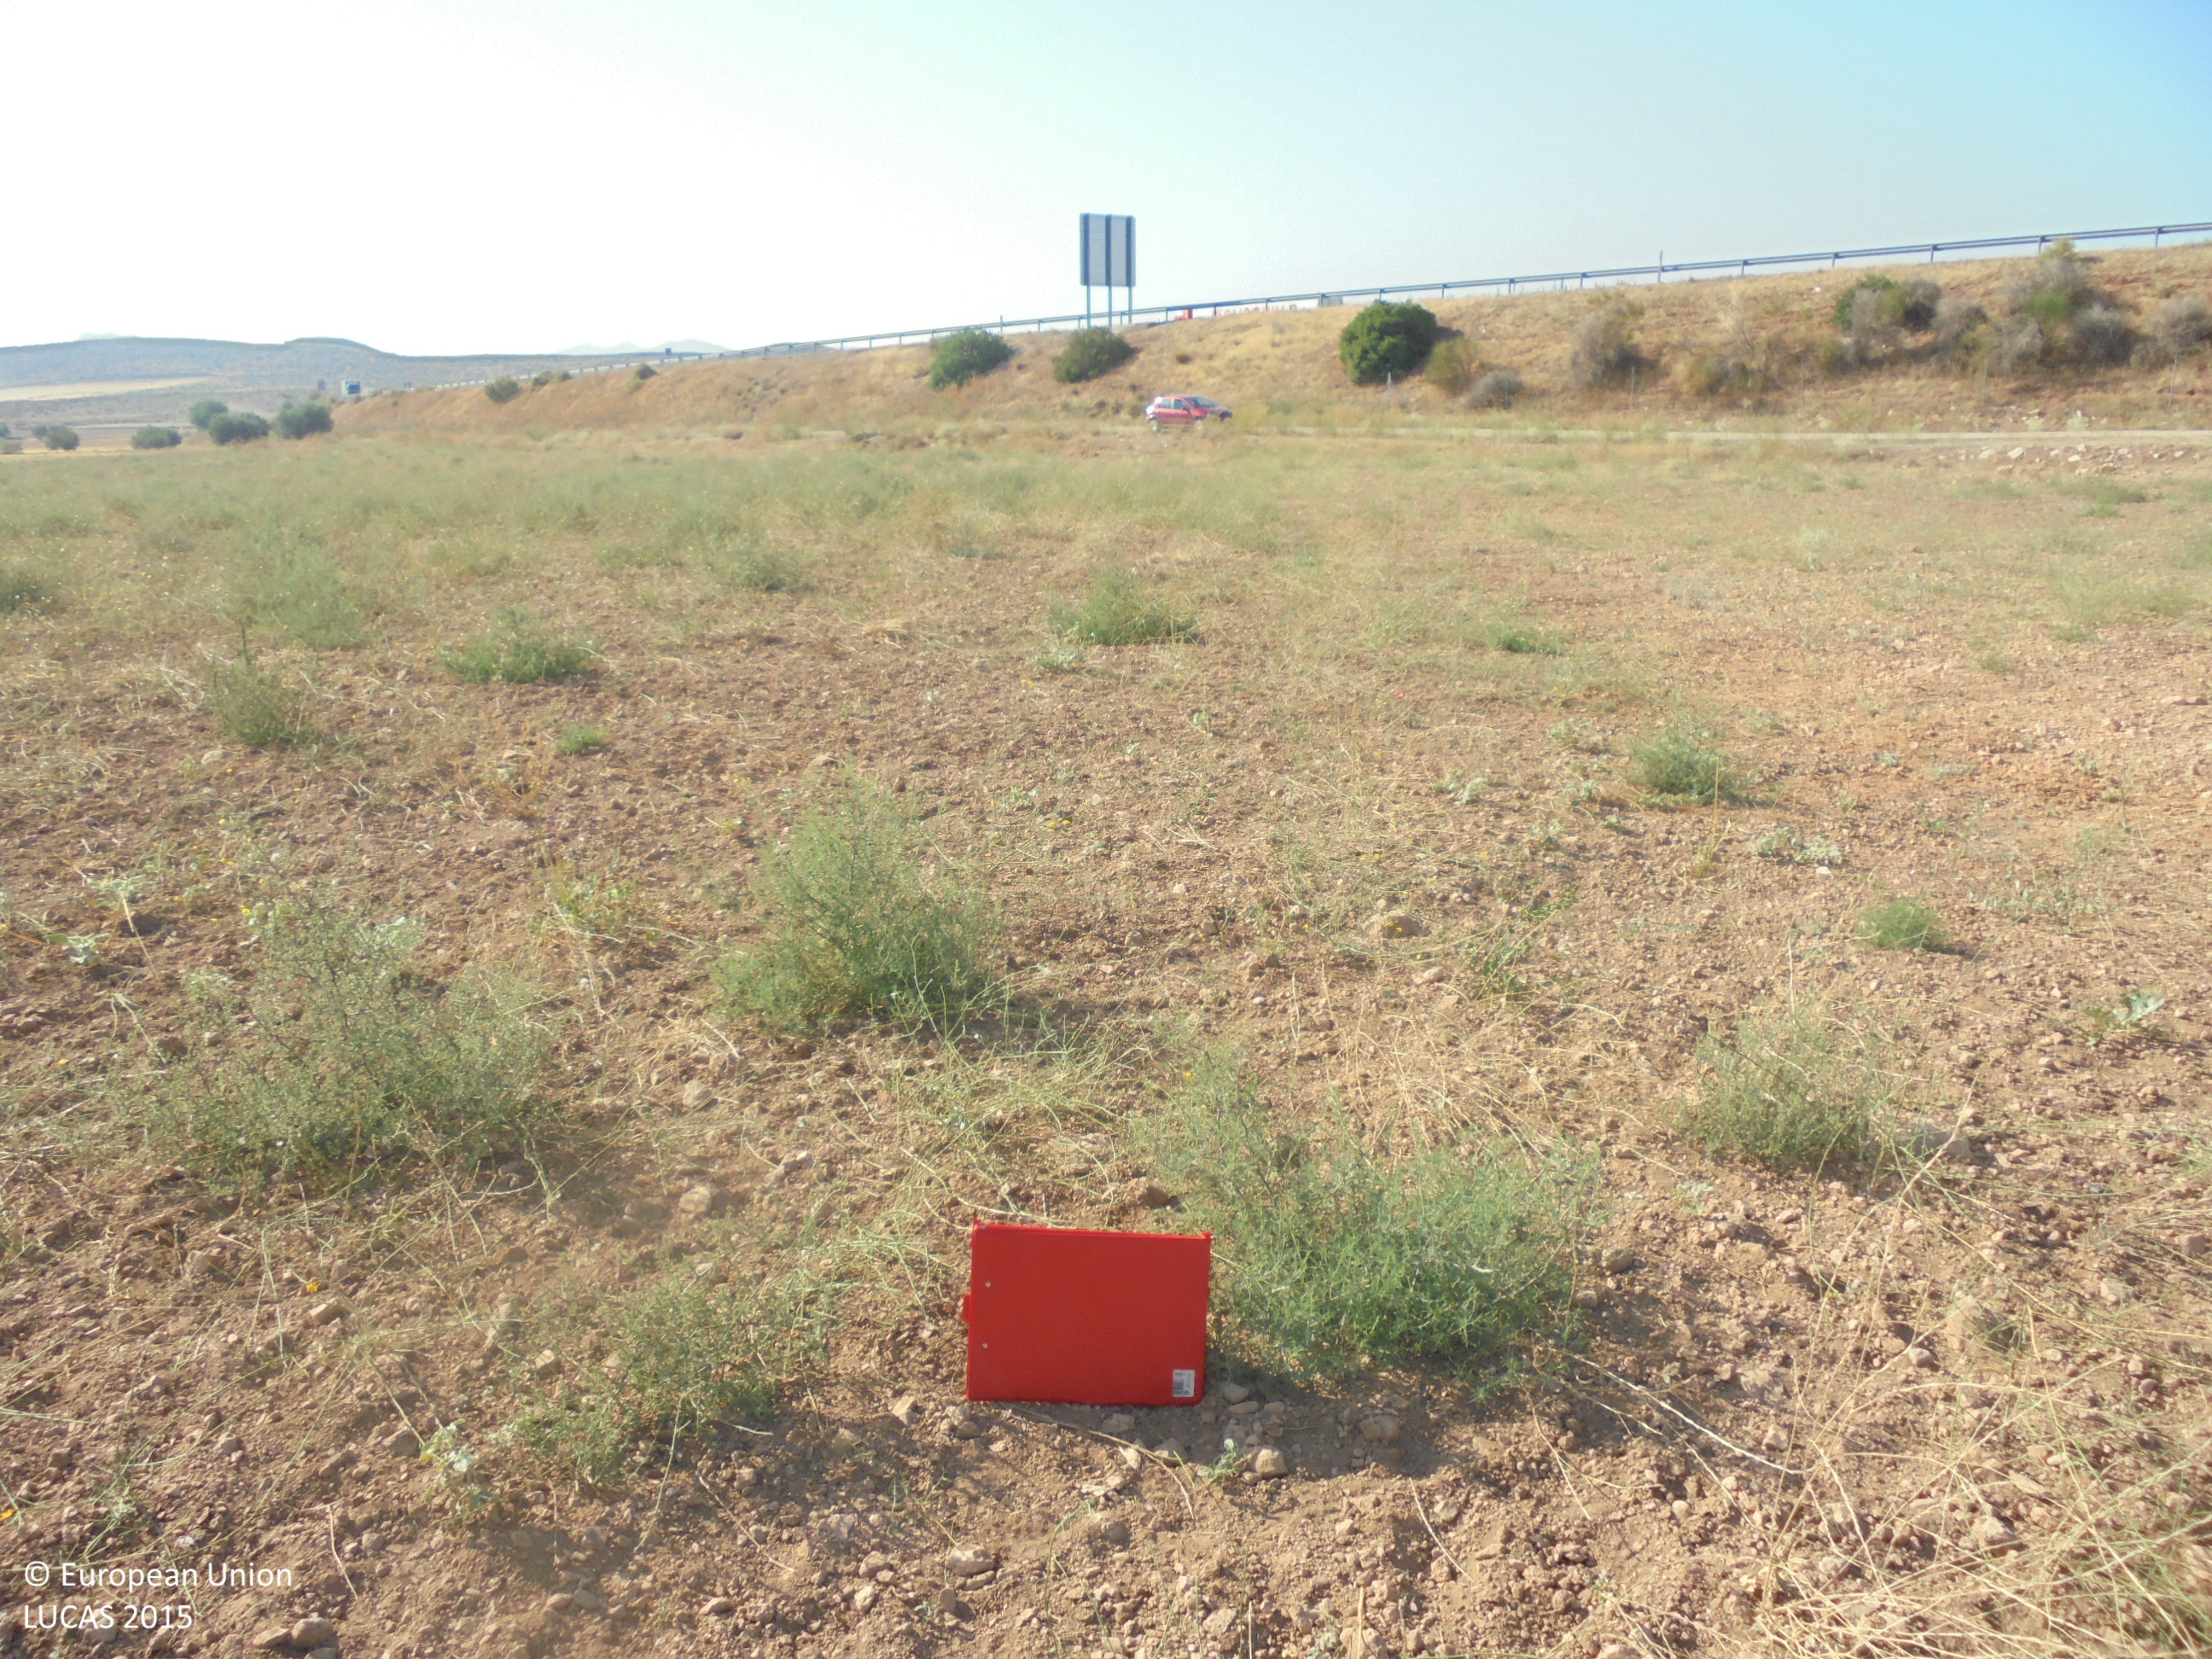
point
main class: Grassland
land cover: Spontaneously vegetated surfaces
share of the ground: 10 - 25 %
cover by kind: unconsolidated bare surface 80 %, herbaceous plants 20 %
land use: Agriculture (excluding fallow land and kitchen gardens)
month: July
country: ES
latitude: 38.5102
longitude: -1.6560
